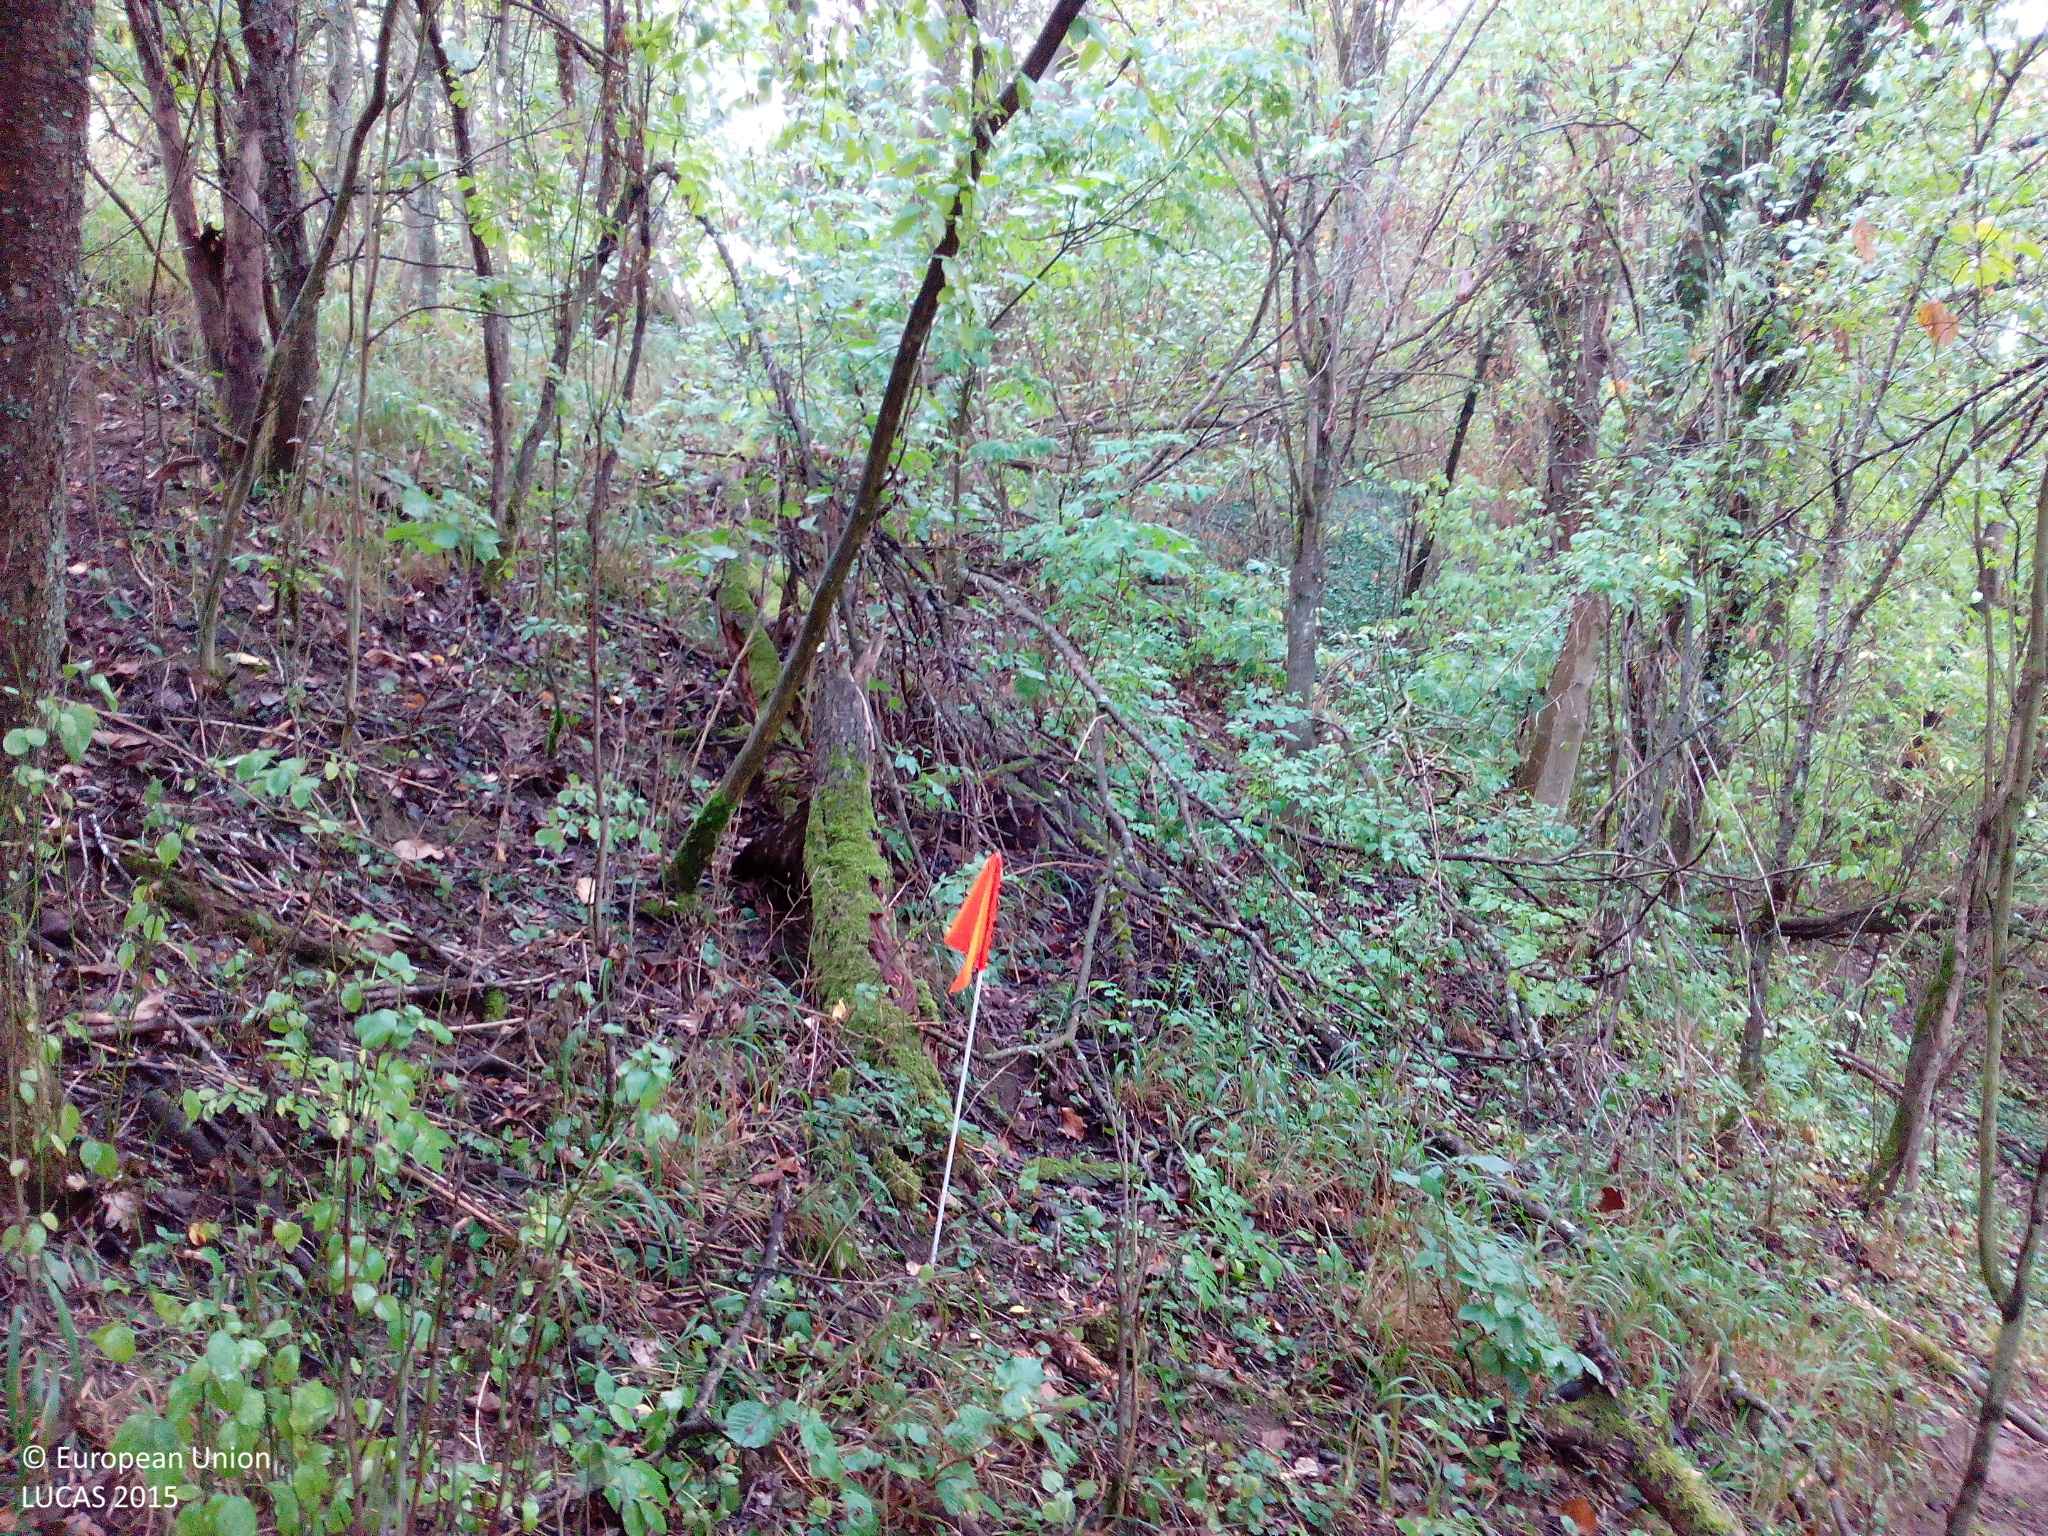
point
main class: Woodland
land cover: Broadleaved woodland
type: mesophytic deciduous forest
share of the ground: > 75 %
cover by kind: broadleaved forest trees 75 %, shrubs 20 %, herbaceous plants 5 %
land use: Semi-natural and natural areas not in use
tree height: < 5 m
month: September
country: DE
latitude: 49.7690
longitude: 9.4032
